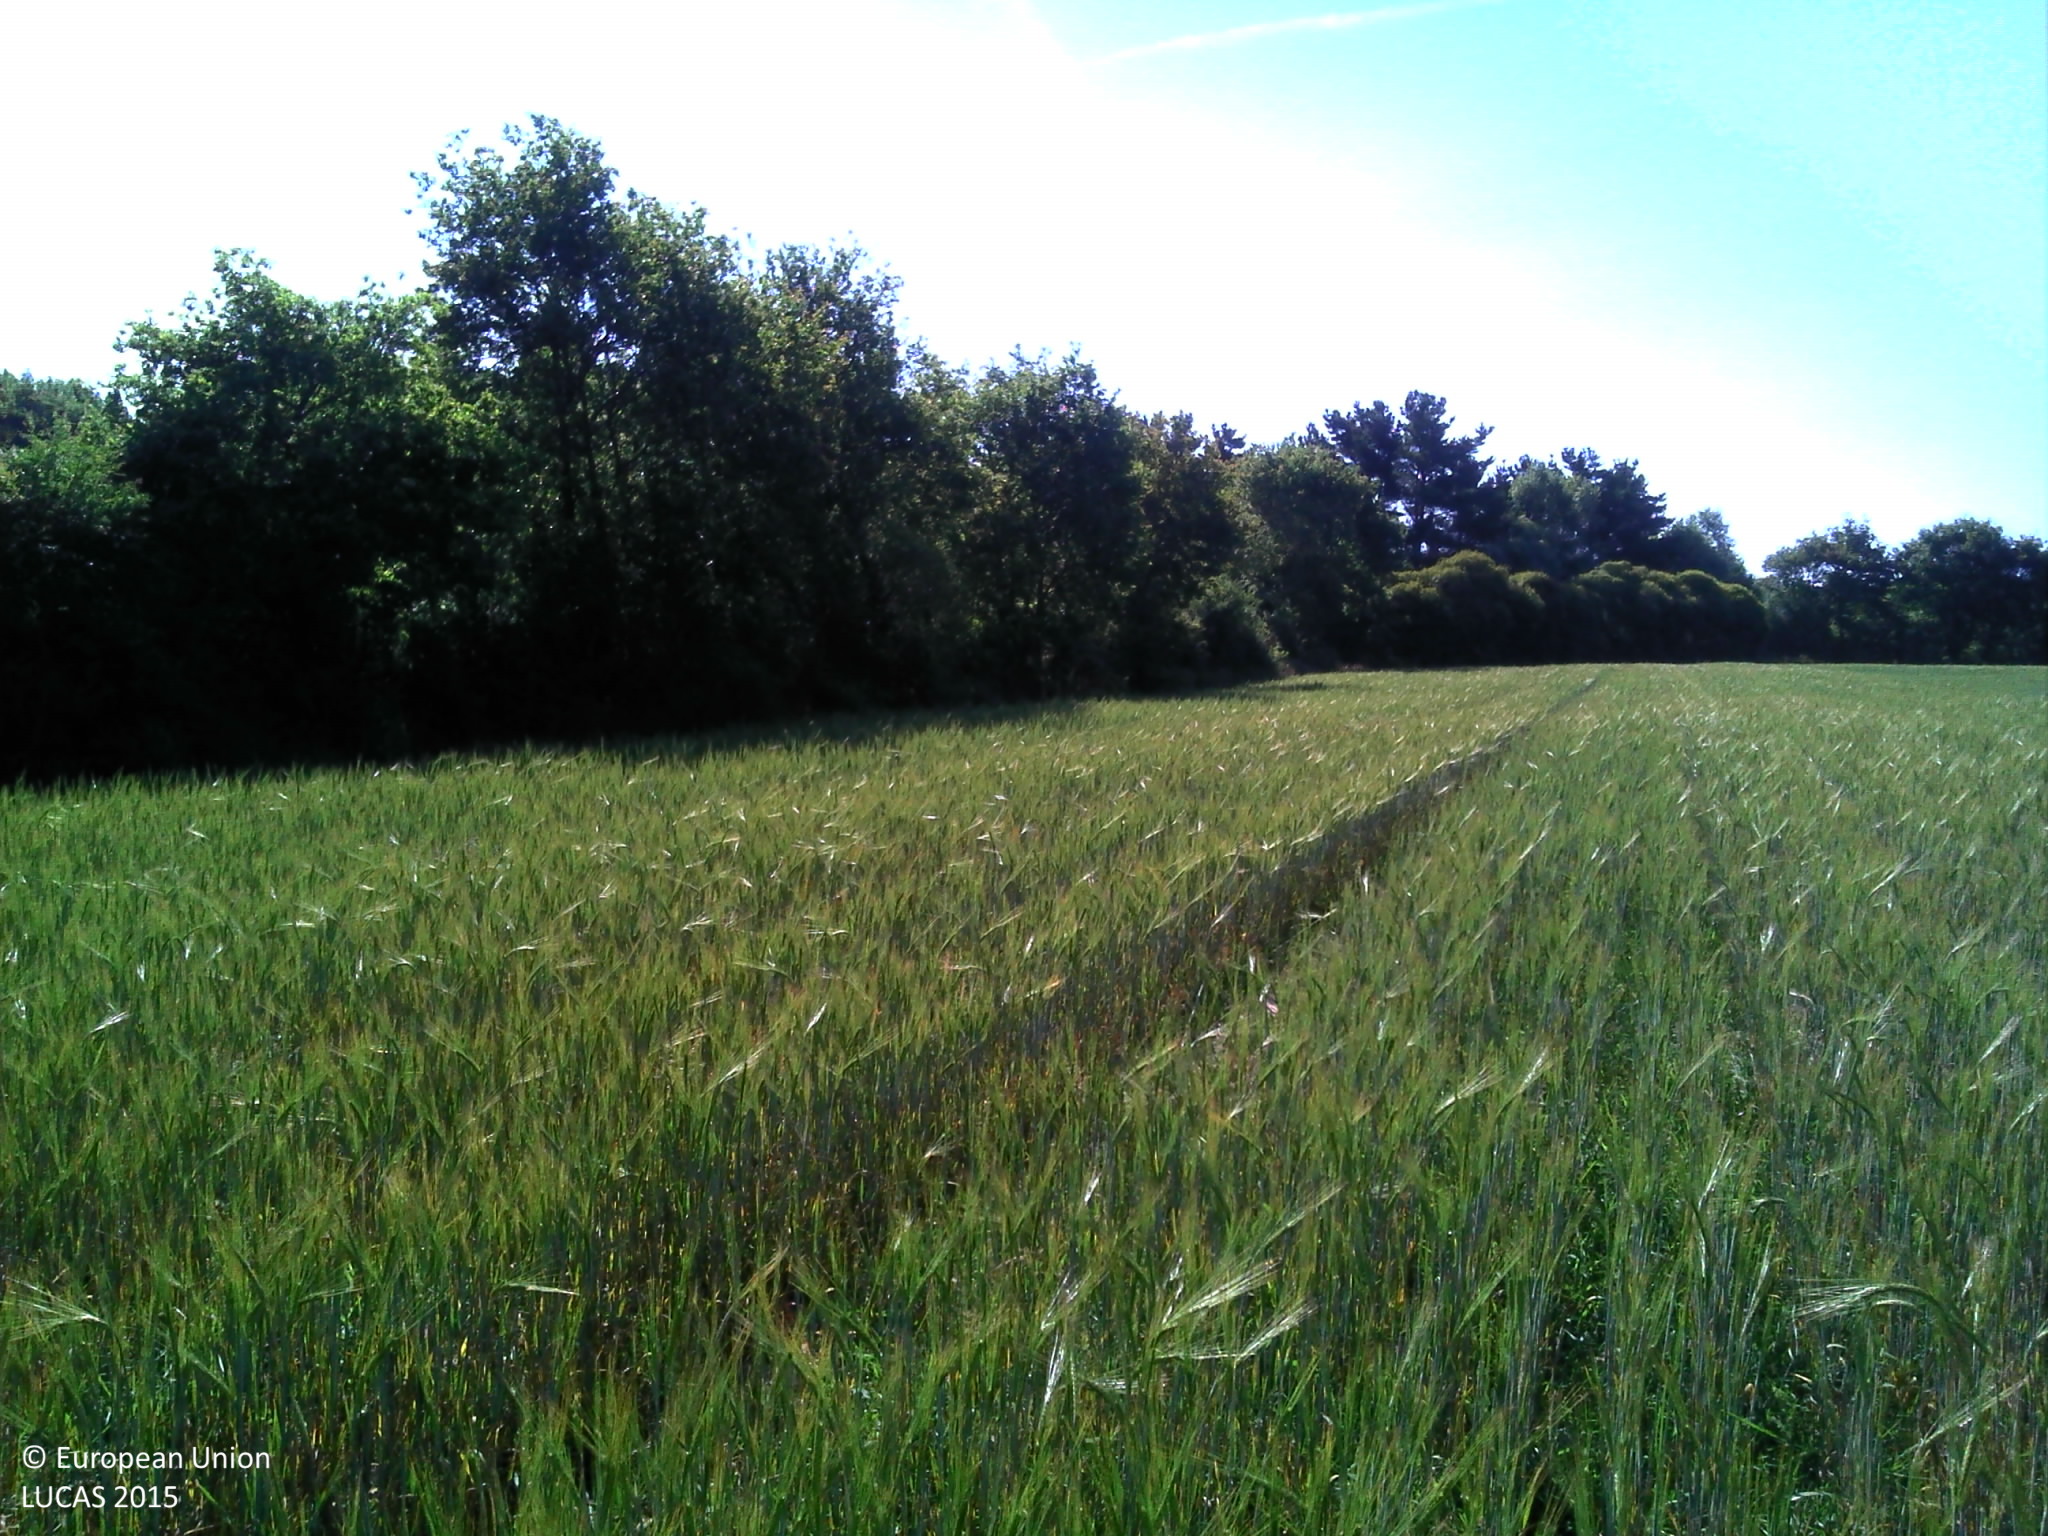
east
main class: Cropland
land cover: Barley
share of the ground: > 75 %
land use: Agriculture (excluding fallow land and kitchen gardens)
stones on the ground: 10 - 25 %
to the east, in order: Barley; Broadleaved woodland; Temporary grasslands; Broadleaved woodland; Fences; Ditches and canals; Grass margins; Tracks; Grass margins; Ditches and canals; Broadleaved woodland; Inland fresh water bodies; Broadleaved woodland; Tracks; Shrubland without tree cover; Broadleaved woodland
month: June
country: FR
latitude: 46.9561
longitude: -1.7515
